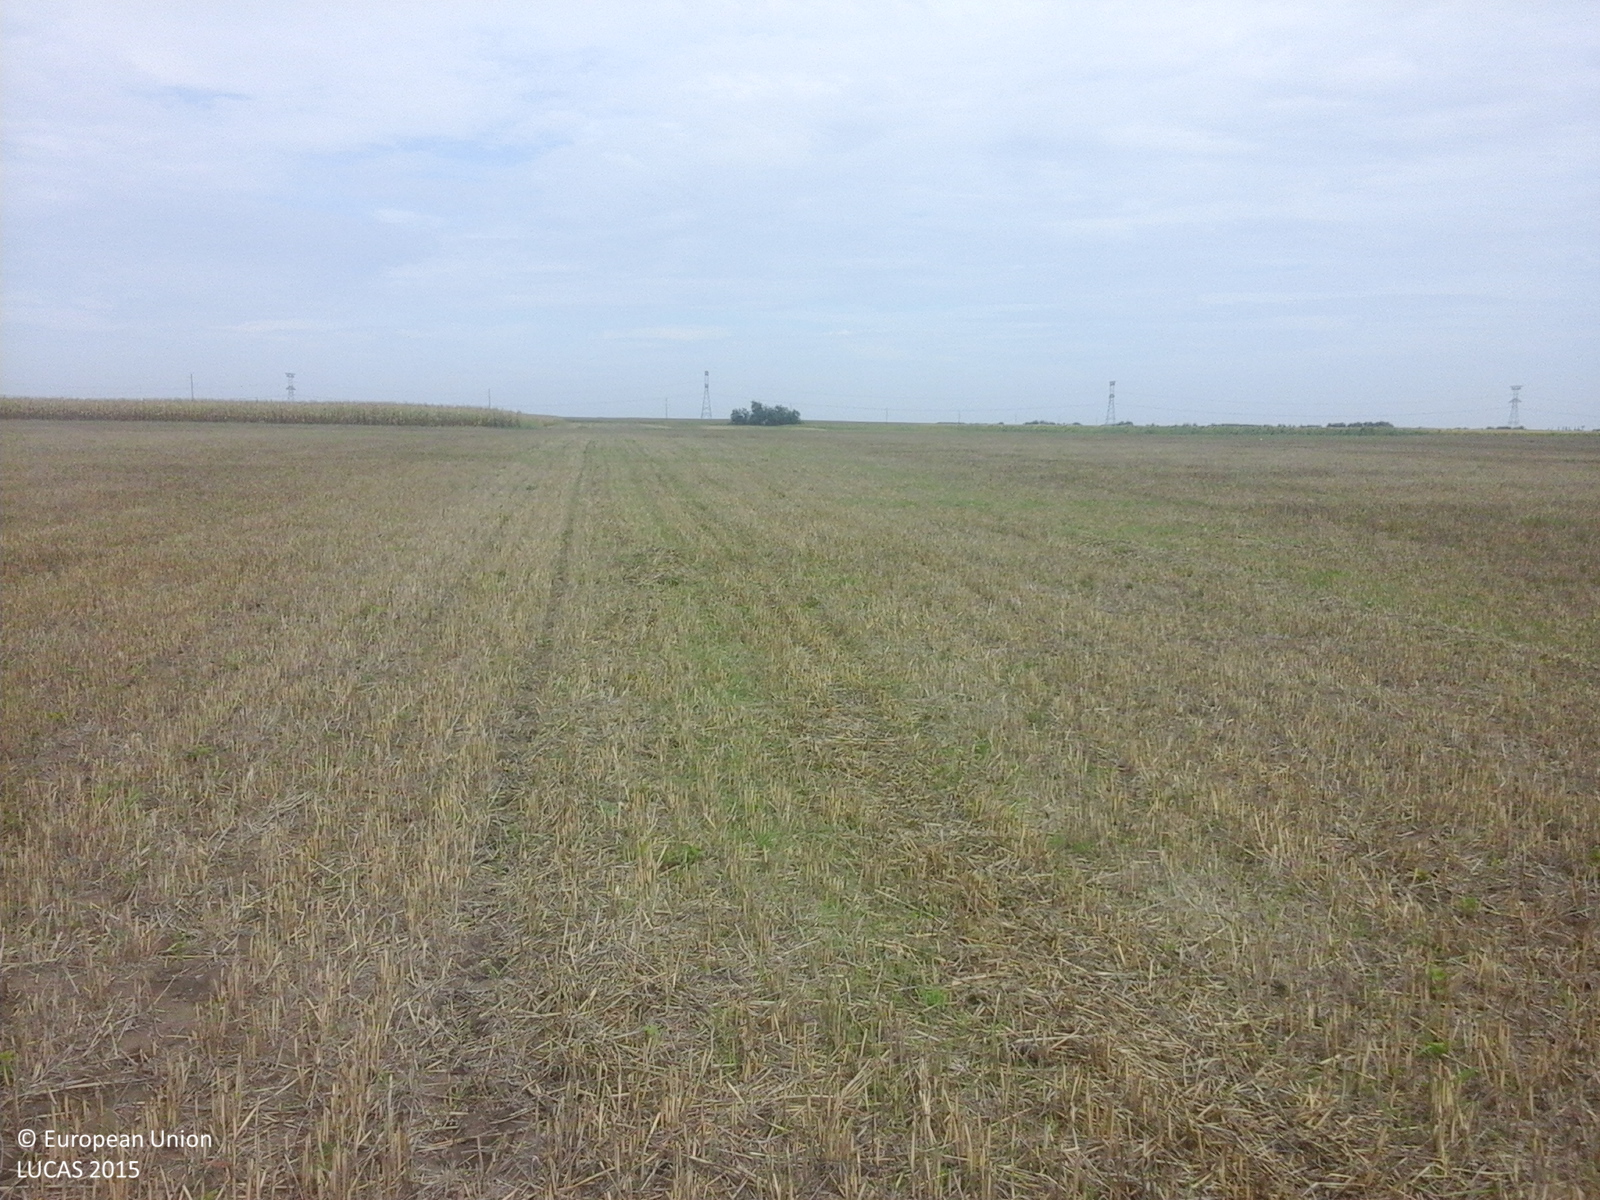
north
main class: Cropland
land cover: Common wheat
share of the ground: 25 - 50 %
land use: Agriculture (excluding fallow land and kitchen gardens)
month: August
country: RO
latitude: 46.4608
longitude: 21.4564
